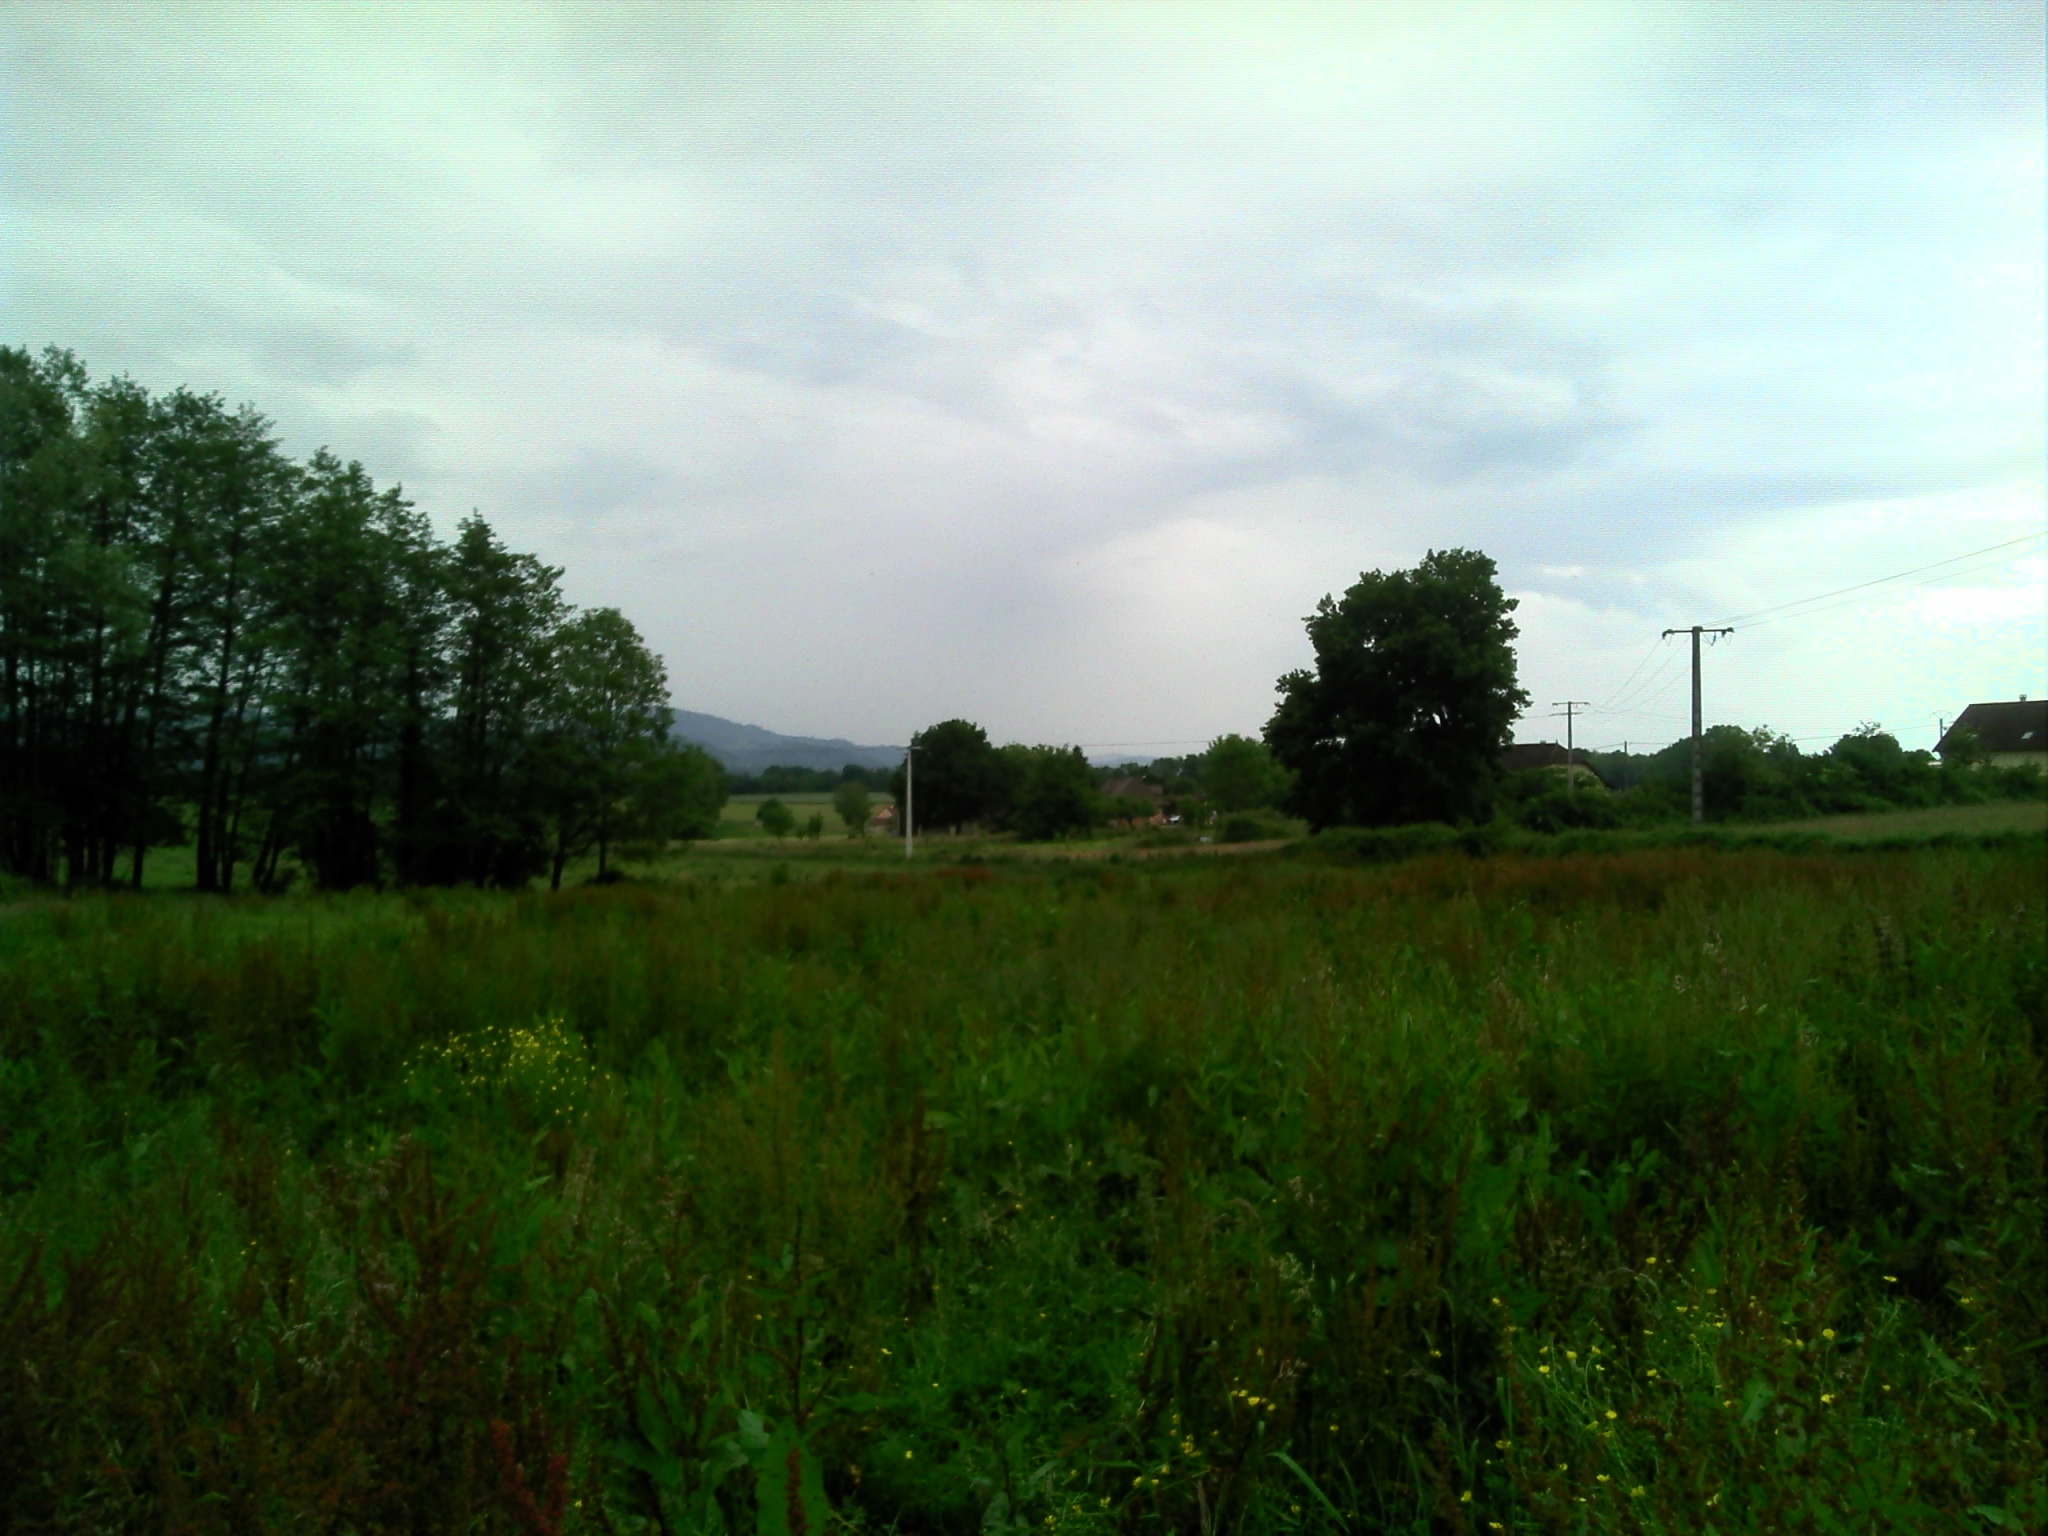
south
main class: Grassland
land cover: Grassland with sparse tree/shrub cover
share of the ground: > 75 %
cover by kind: herbaceous plants 95 %, broadleaved forest trees 5 %
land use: Agriculture (excluding fallow land and kitchen gardens)
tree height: < 5 m
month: May
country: FR
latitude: 46.5948
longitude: 5.3947
